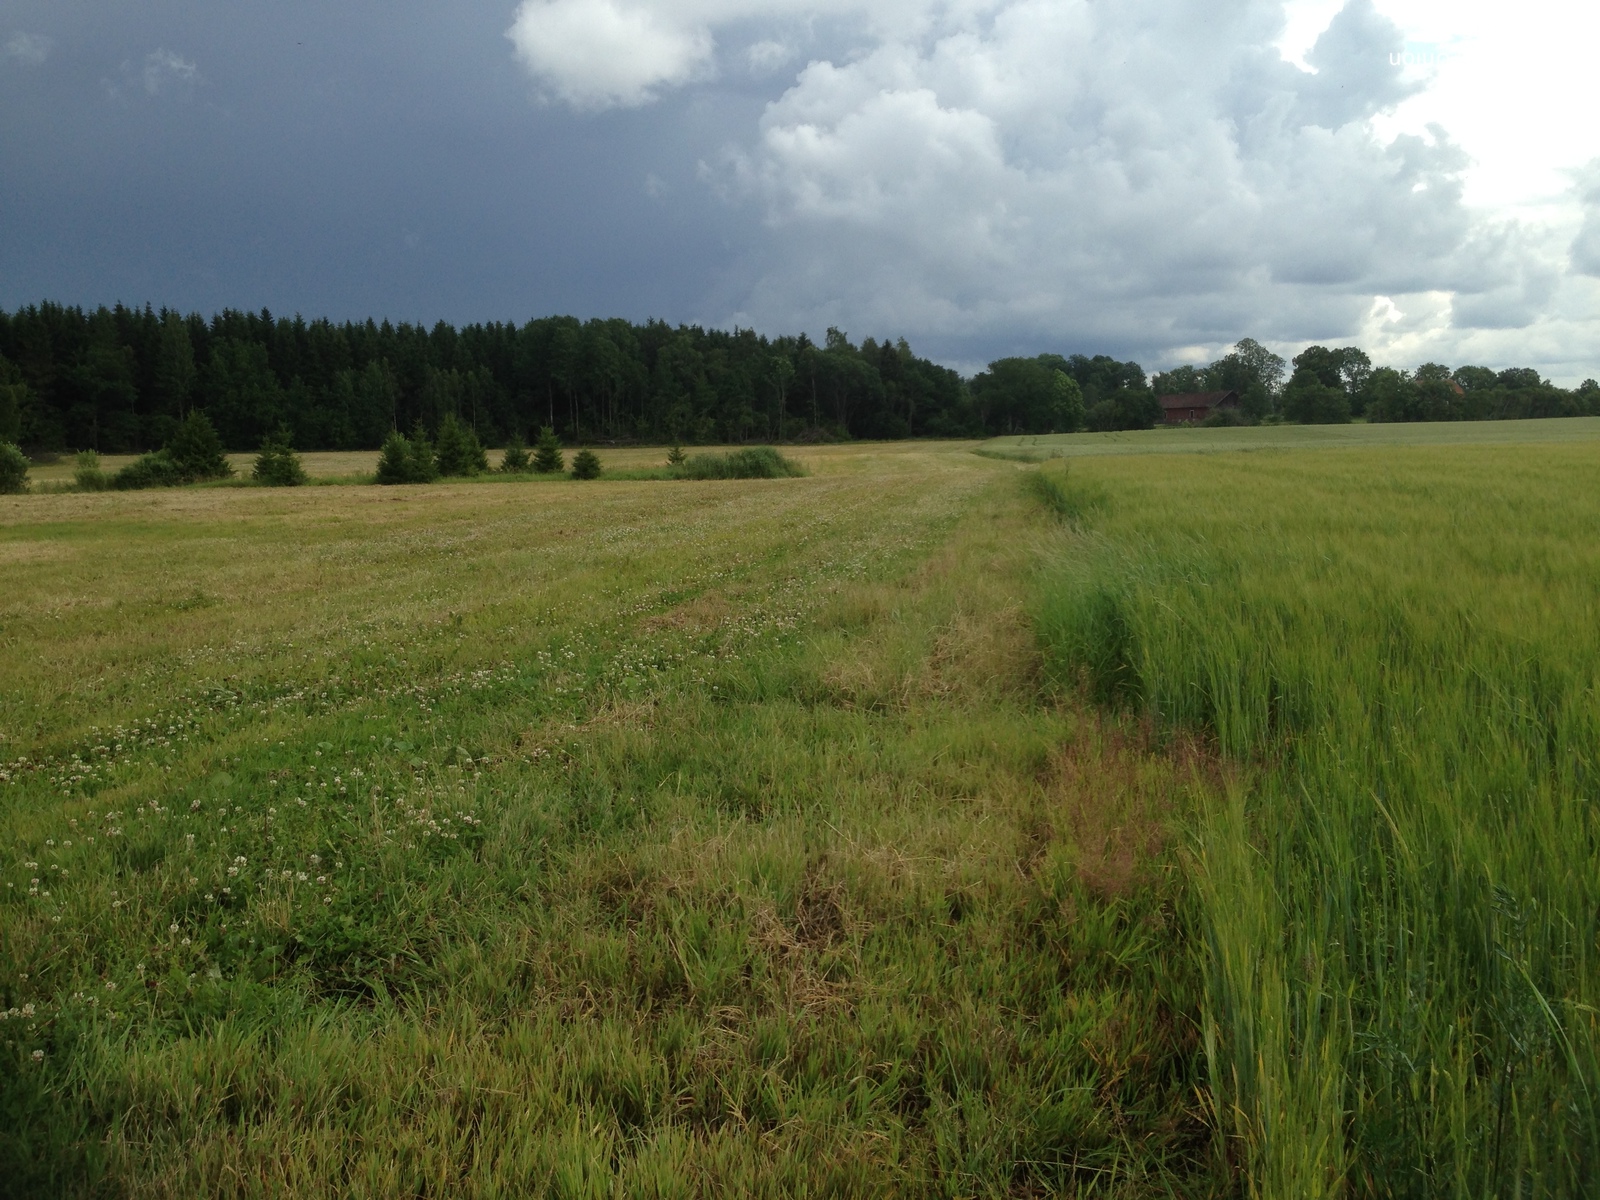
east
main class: Cropland
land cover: Barley
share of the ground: > 75 %
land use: Agriculture (excluding fallow land and kitchen gardens)
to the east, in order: Barley; Common wheat
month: July
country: SE
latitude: 59.8598
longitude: 18.6588
